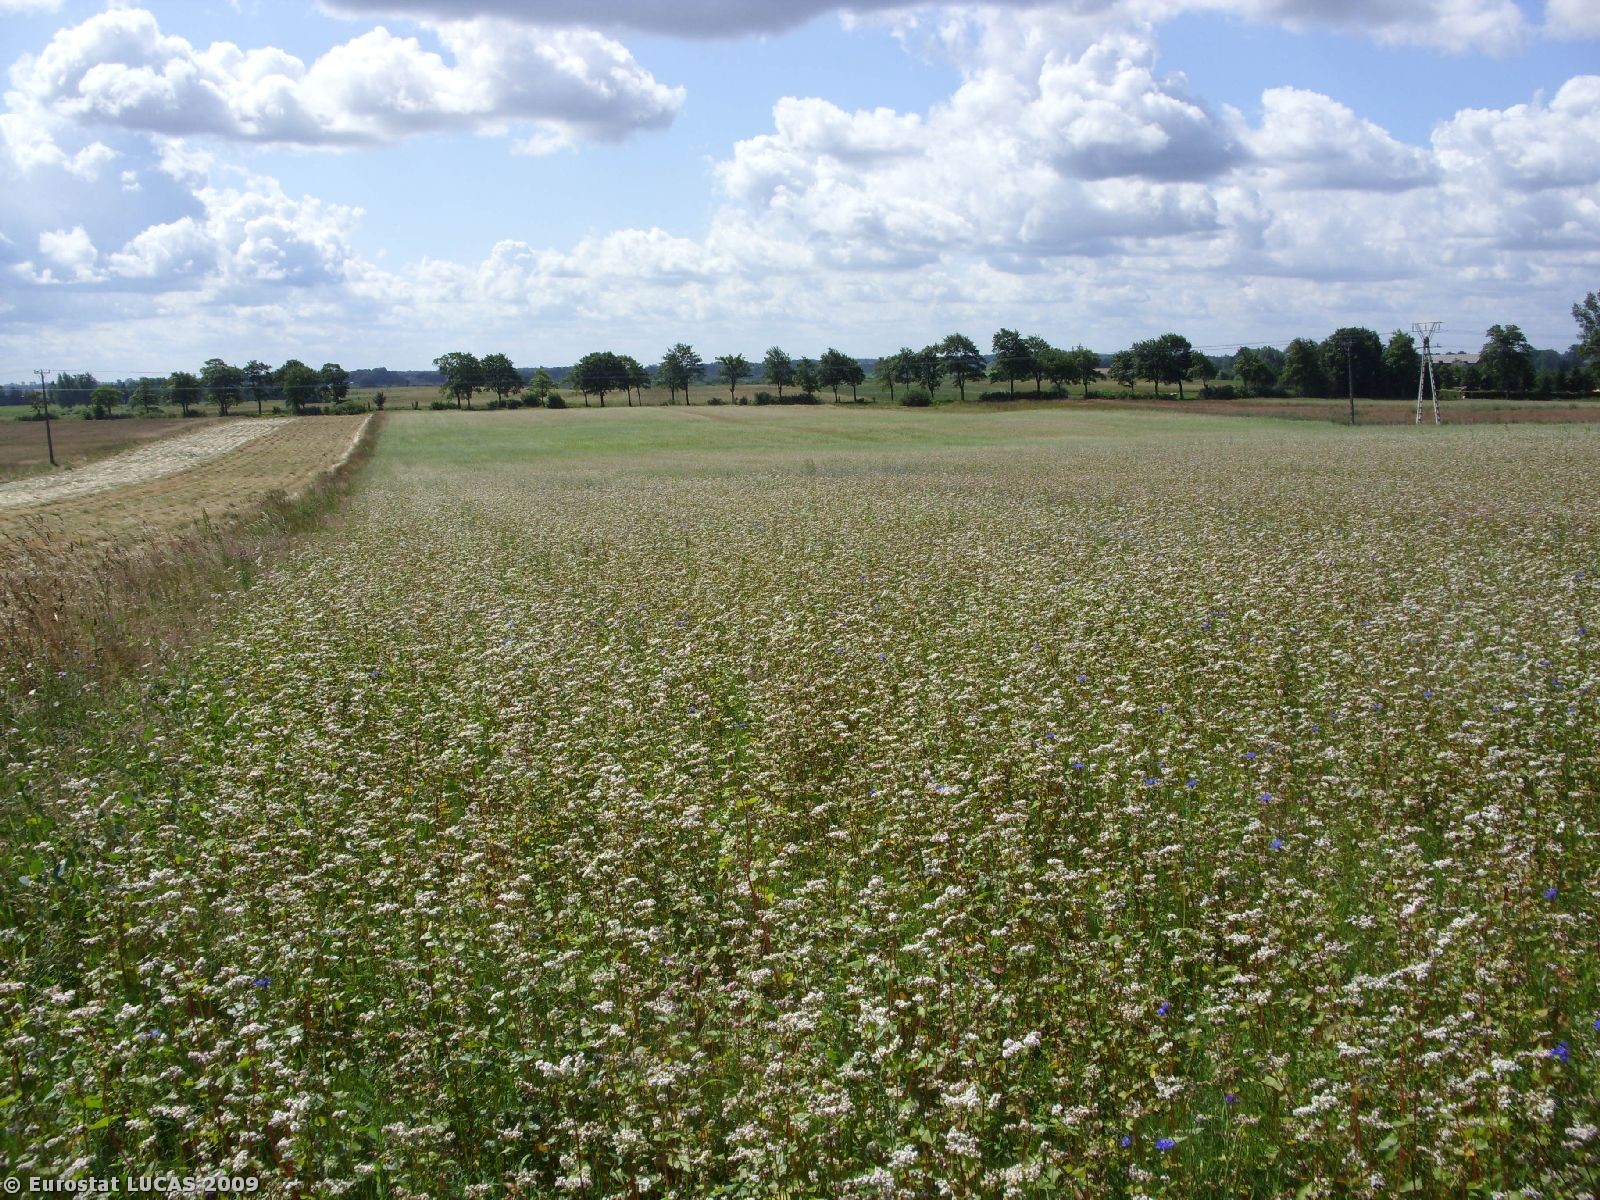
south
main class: Cropland
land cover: Other cereals
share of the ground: > 75 %
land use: Agriculture (excluding fallow land and kitchen gardens)
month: July
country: PL
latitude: 54.2444
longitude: 16.0044
